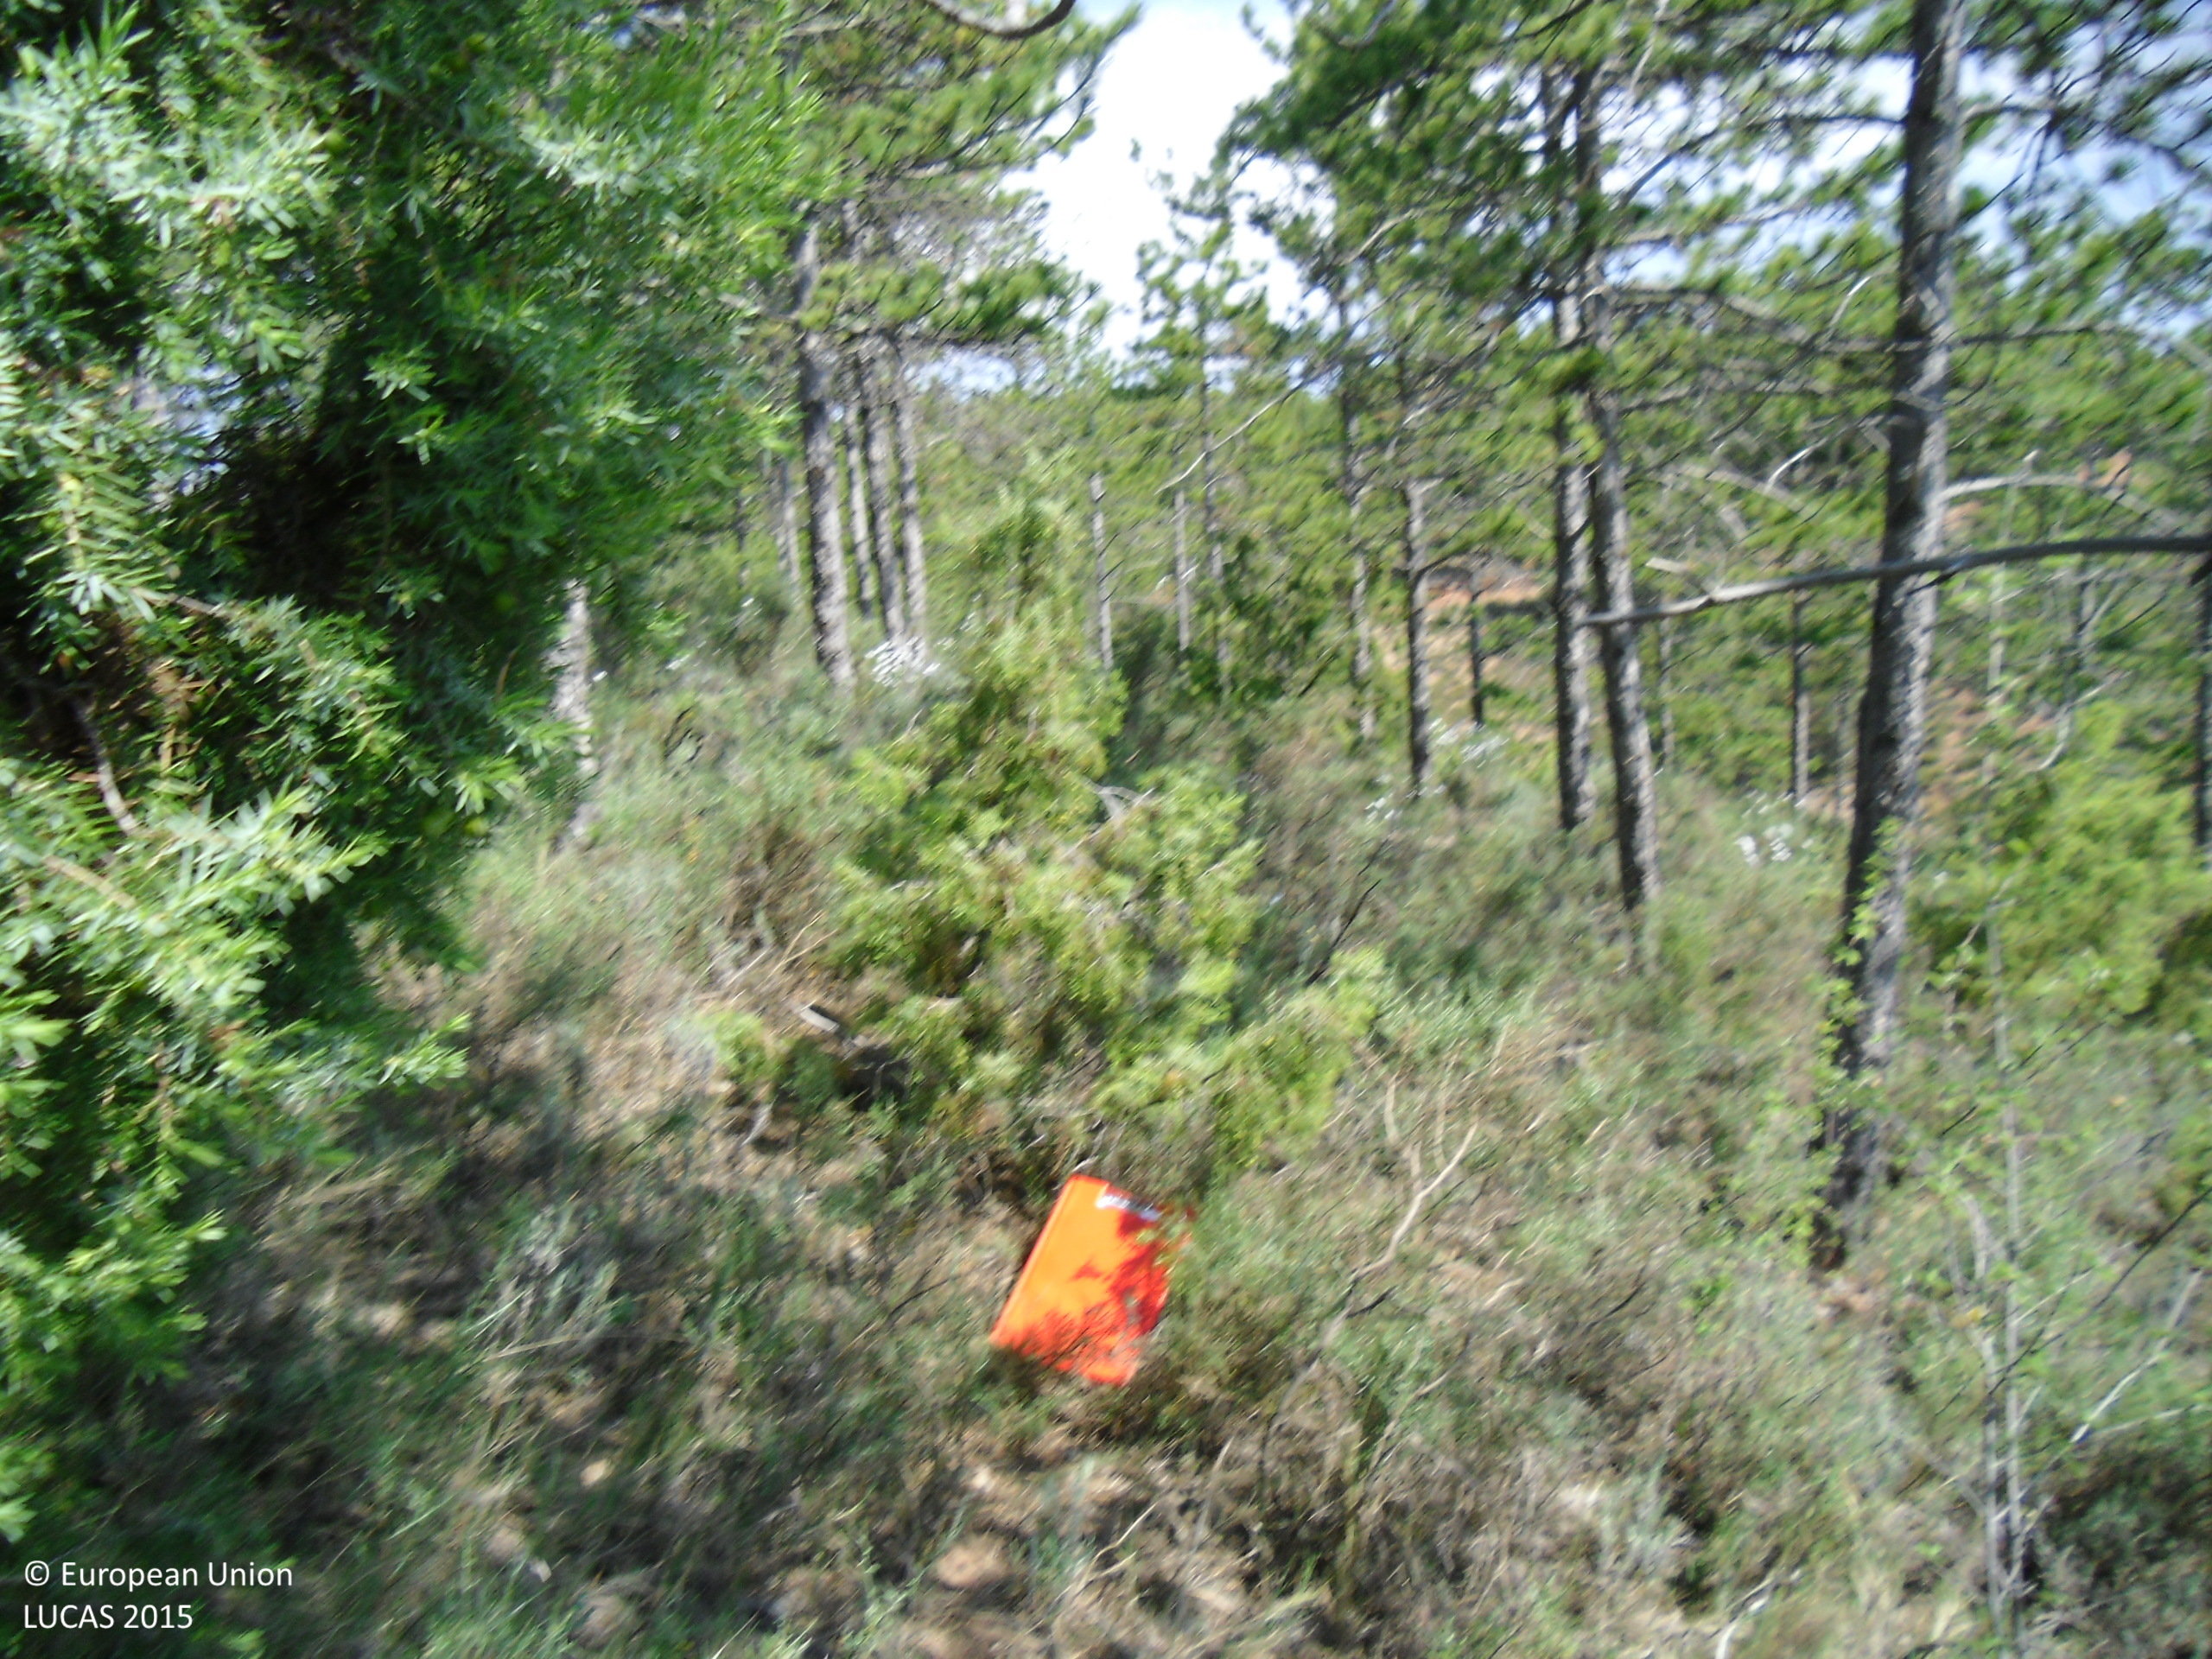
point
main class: Woodland
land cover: Pine dominated coniferous woodland
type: coniferous forest of the mediterranean region
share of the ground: > 75 %
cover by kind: coniferous forest trees 90 %, herbaceous plants 5 %, consolidated bare surface 5 %
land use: Semi-natural and natural areas not in use
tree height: > 5 m
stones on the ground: 10 - 25 %
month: May
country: ES
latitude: 40.8497
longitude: -0.8435
